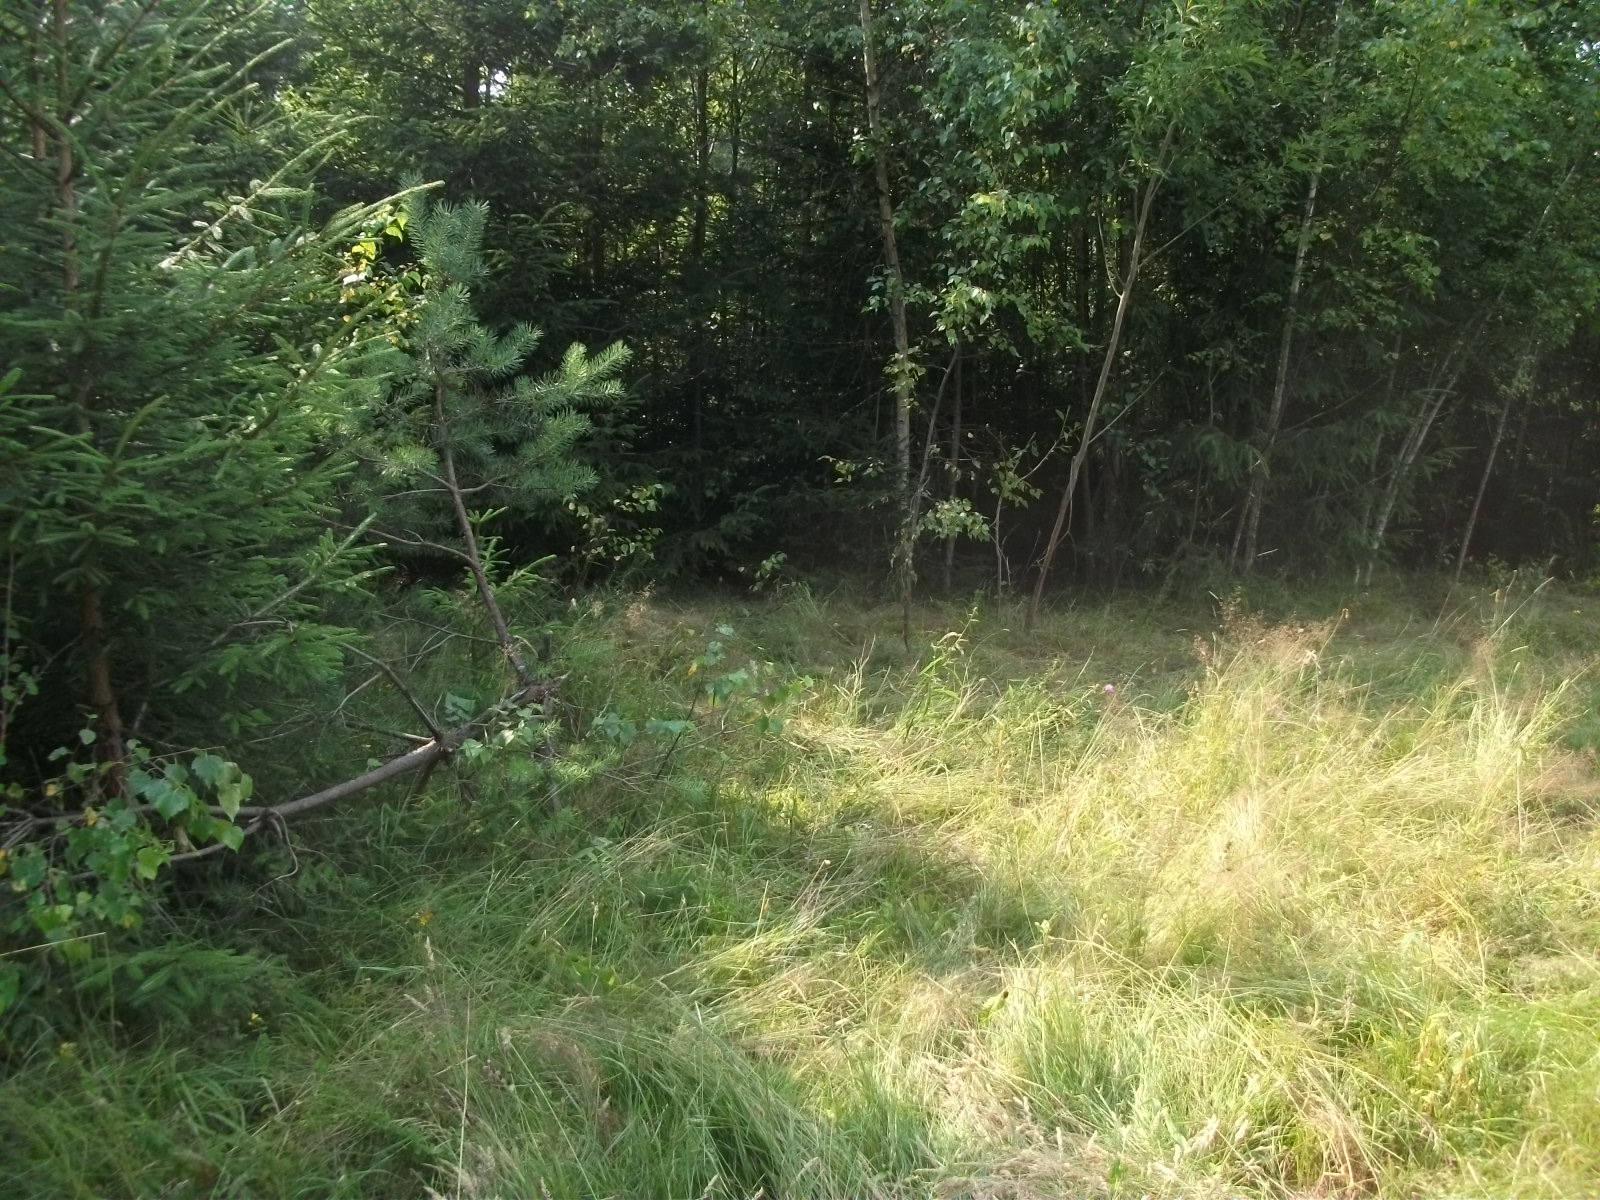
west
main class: Grassland
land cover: Grassland without tree/shrub cover
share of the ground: > 75 %
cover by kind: herbaceous plants 100 %
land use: Agriculture (excluding fallow land and kitchen gardens)
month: August
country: LV
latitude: 56.8742
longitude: 25.6266
